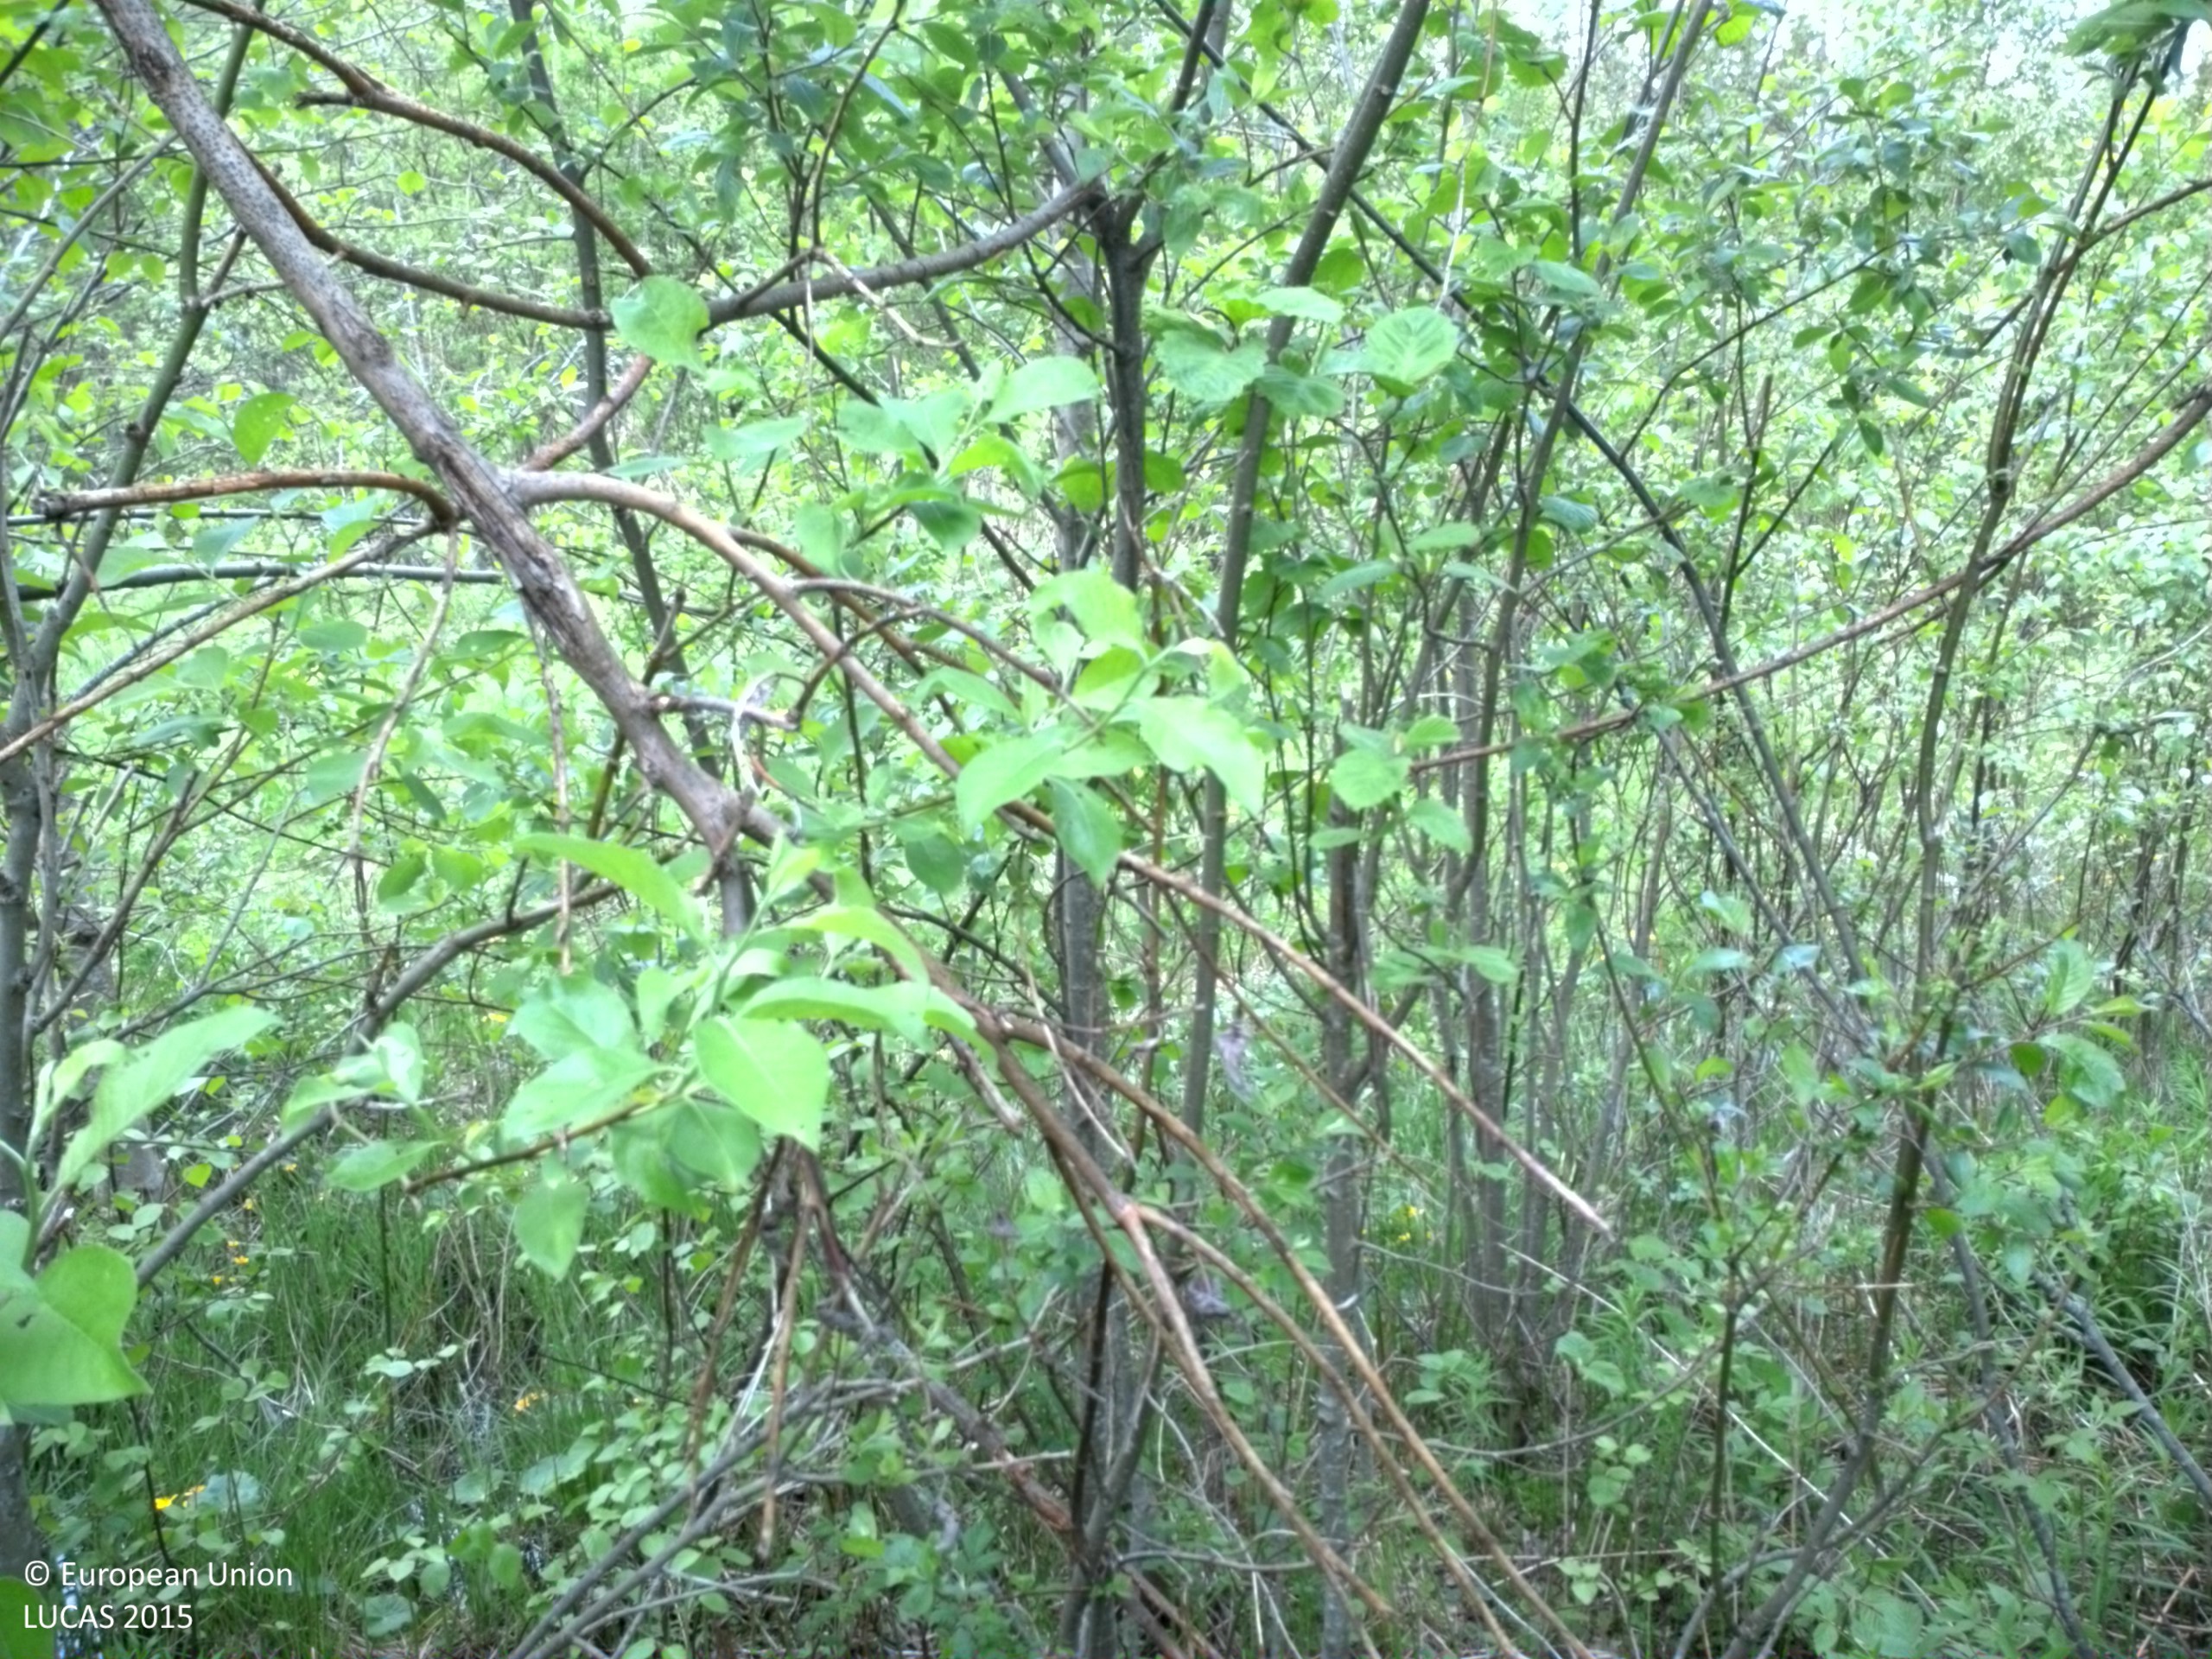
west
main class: Woodland
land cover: Broadleaved woodland
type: hemiboreal forest and nemoral coniferous forest and mixed broadleaved-coniferous forest
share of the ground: > 75 %
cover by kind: broadleaved forest trees 85 %, herbaceous plants 15 %
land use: Forestry
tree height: < 5 m
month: June
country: SE
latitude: 62.9637
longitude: 17.9645
